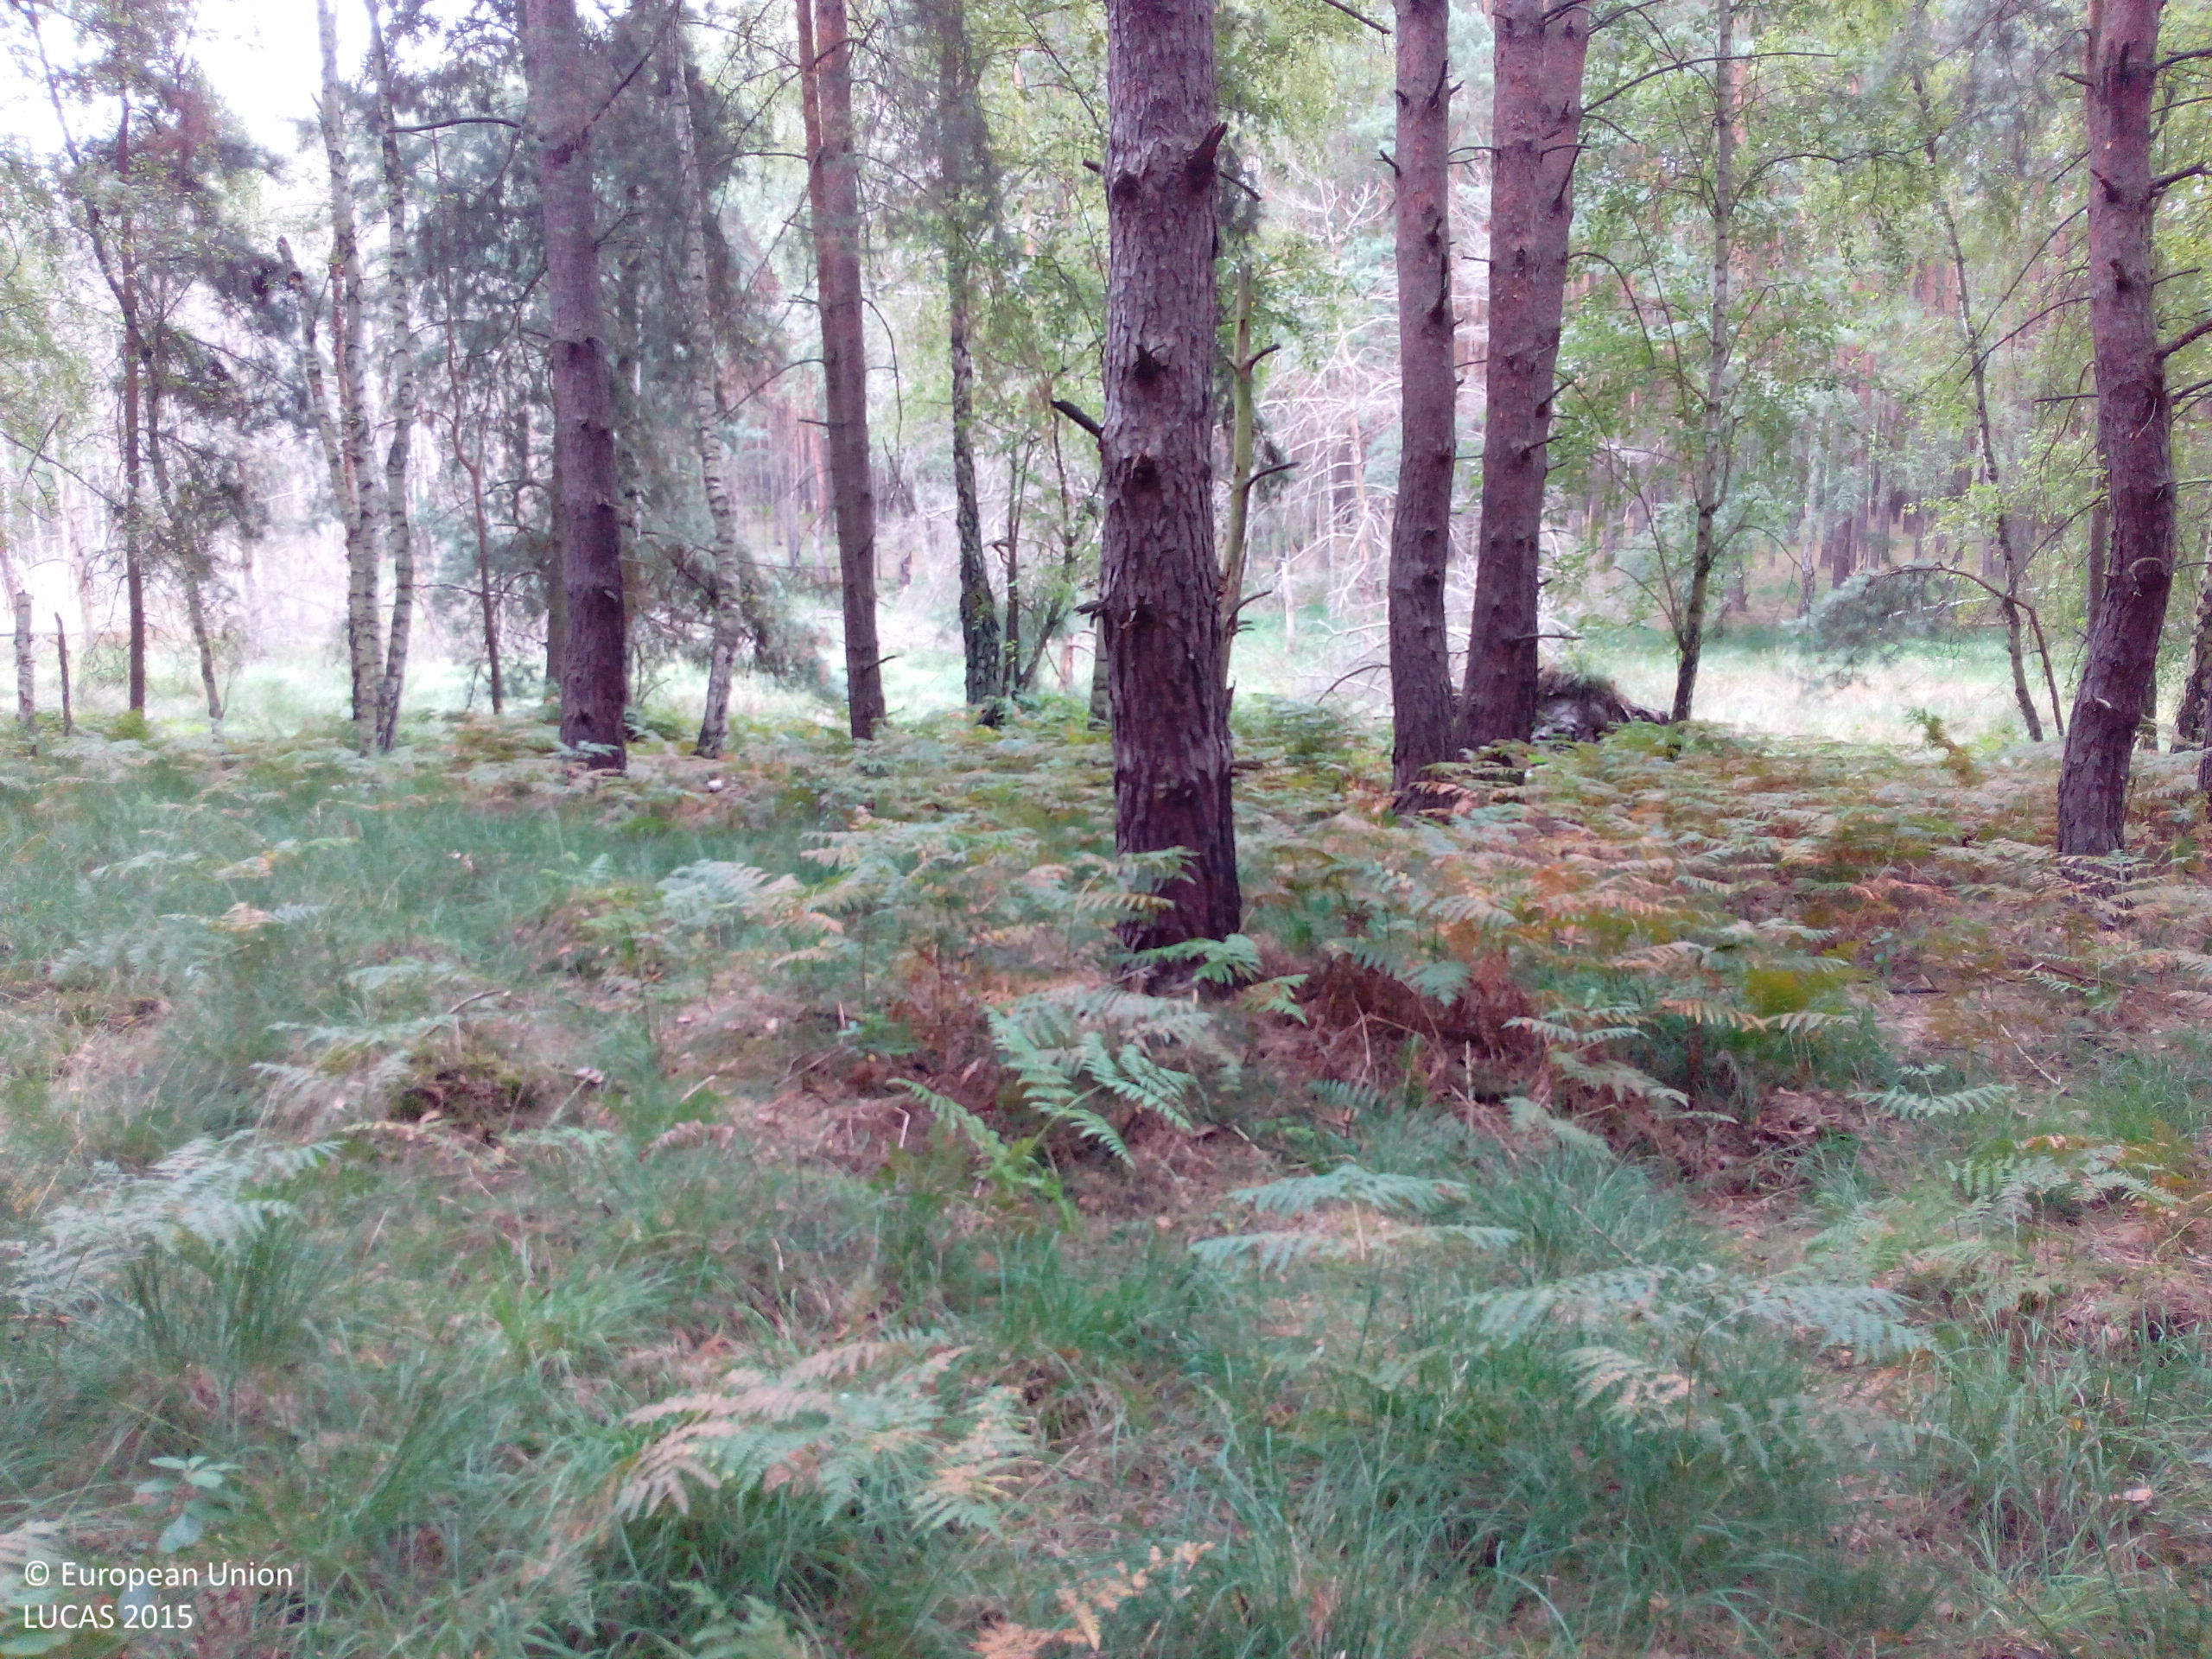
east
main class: Woodland
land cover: Pine dominated coniferous woodland
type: hemiboreal forest and nemoral coniferous forest and mixed broadleaved-coniferous forest
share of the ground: > 75 %
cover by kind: coniferous forest trees 100 %
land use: Forestry
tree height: > 5 m
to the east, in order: Pine dominated coniferous woodland; Pine dominated mixed woodland; Inland marshes; Pine dominated coniferous woodland; Tracks; Pine dominated coniferous woodland; Tracks; Pine dominated coniferous woodland
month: August
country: DE
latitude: 51.9651
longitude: 14.0909
